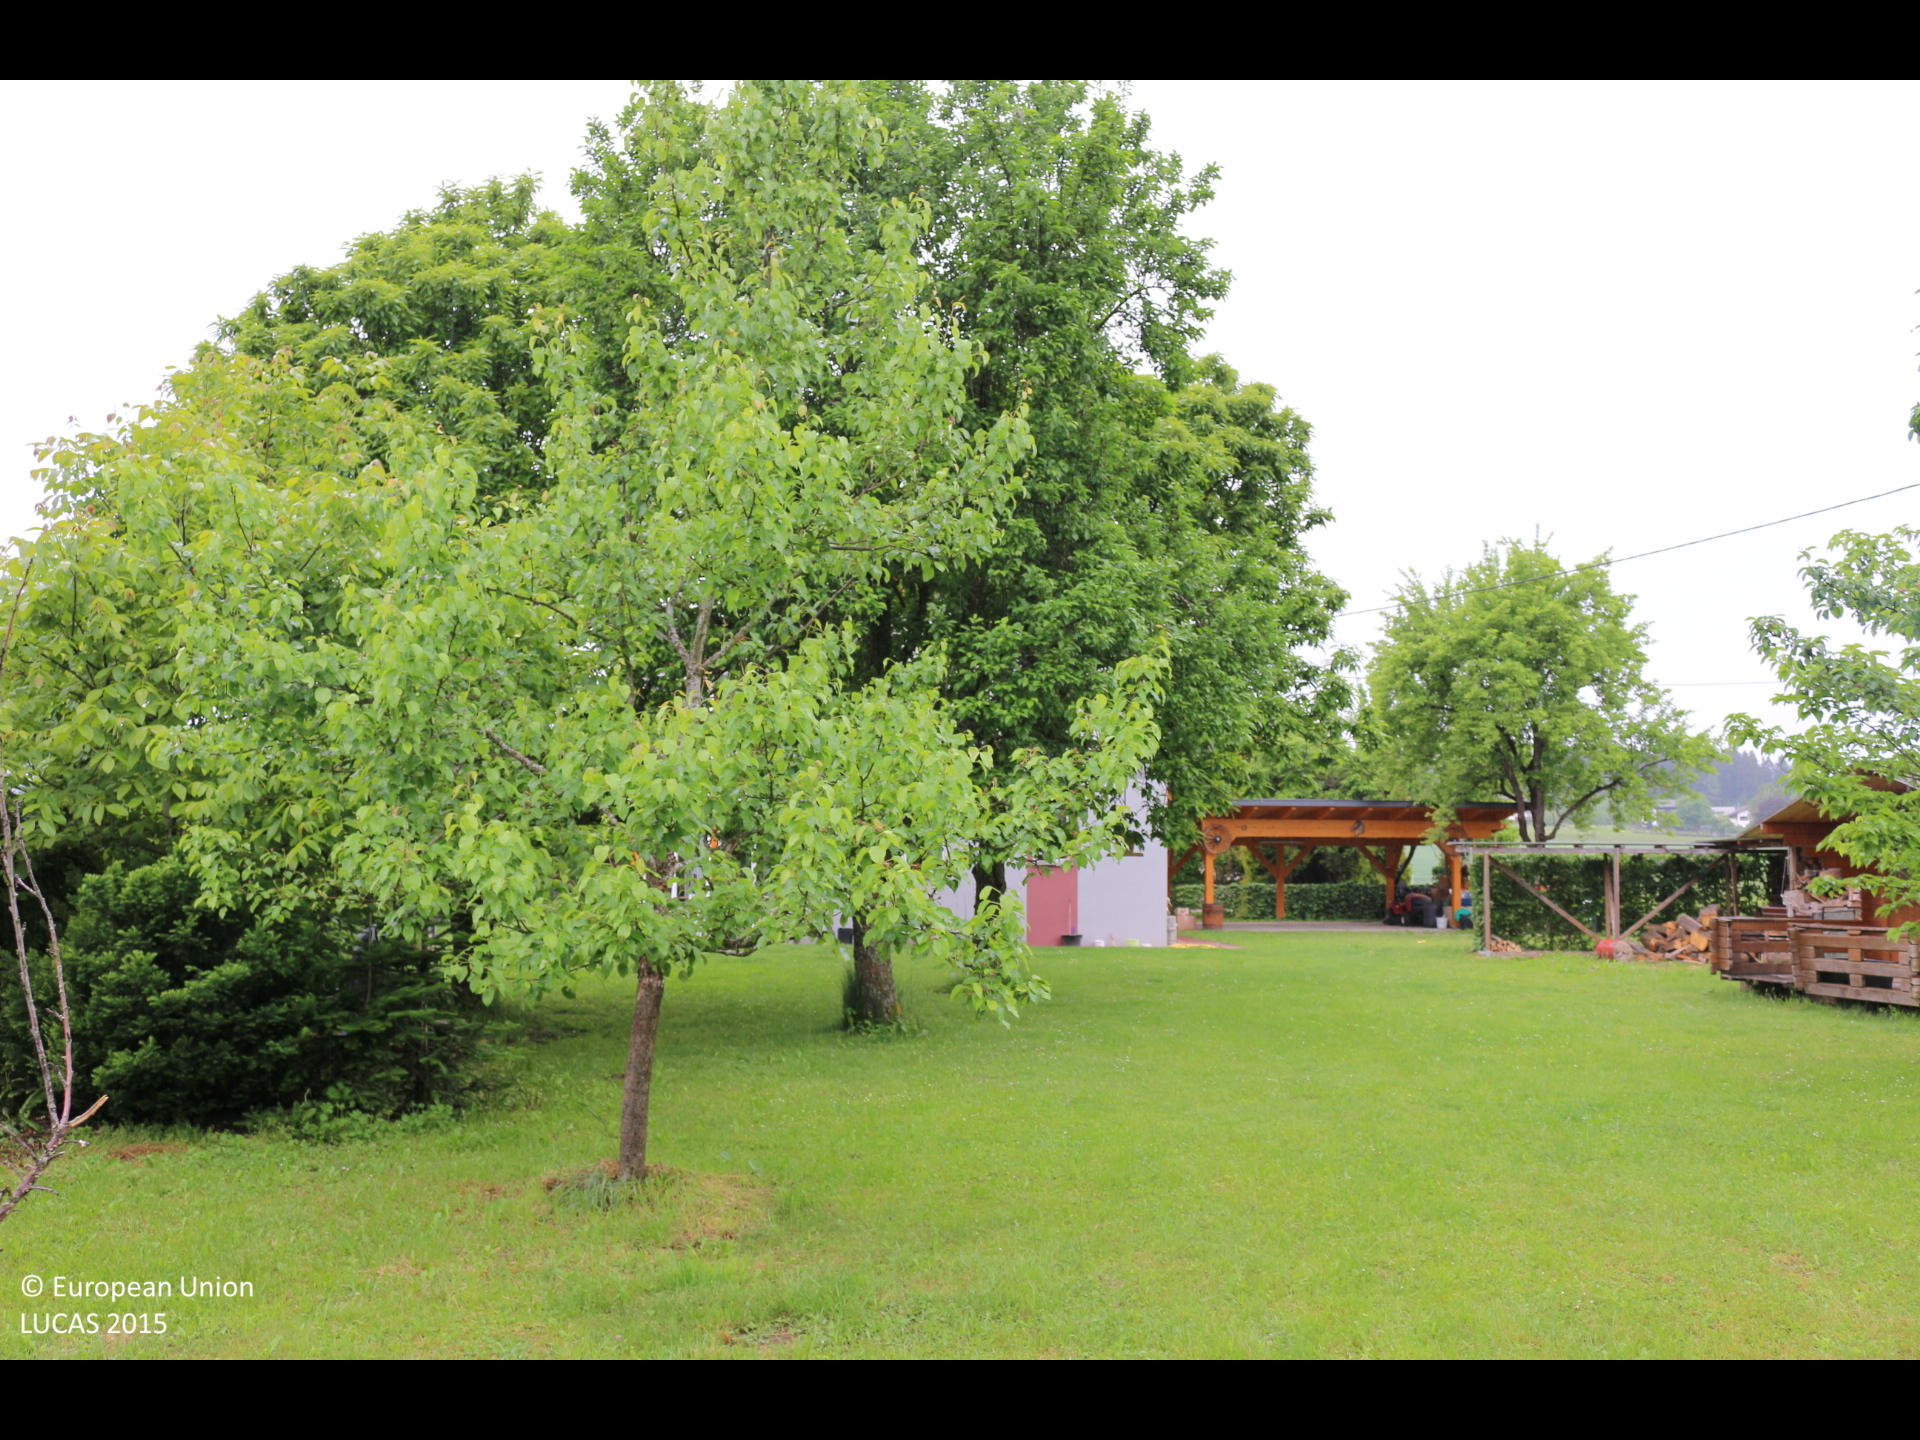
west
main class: Grassland
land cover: Grassland with sparse tree/shrub cover
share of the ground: > 75 %
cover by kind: herbaceous plants 90 %, broadleaved forest trees 5 %, shrubs 5 %
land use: Residential
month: May
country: AT
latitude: 46.6858
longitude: 14.1422
